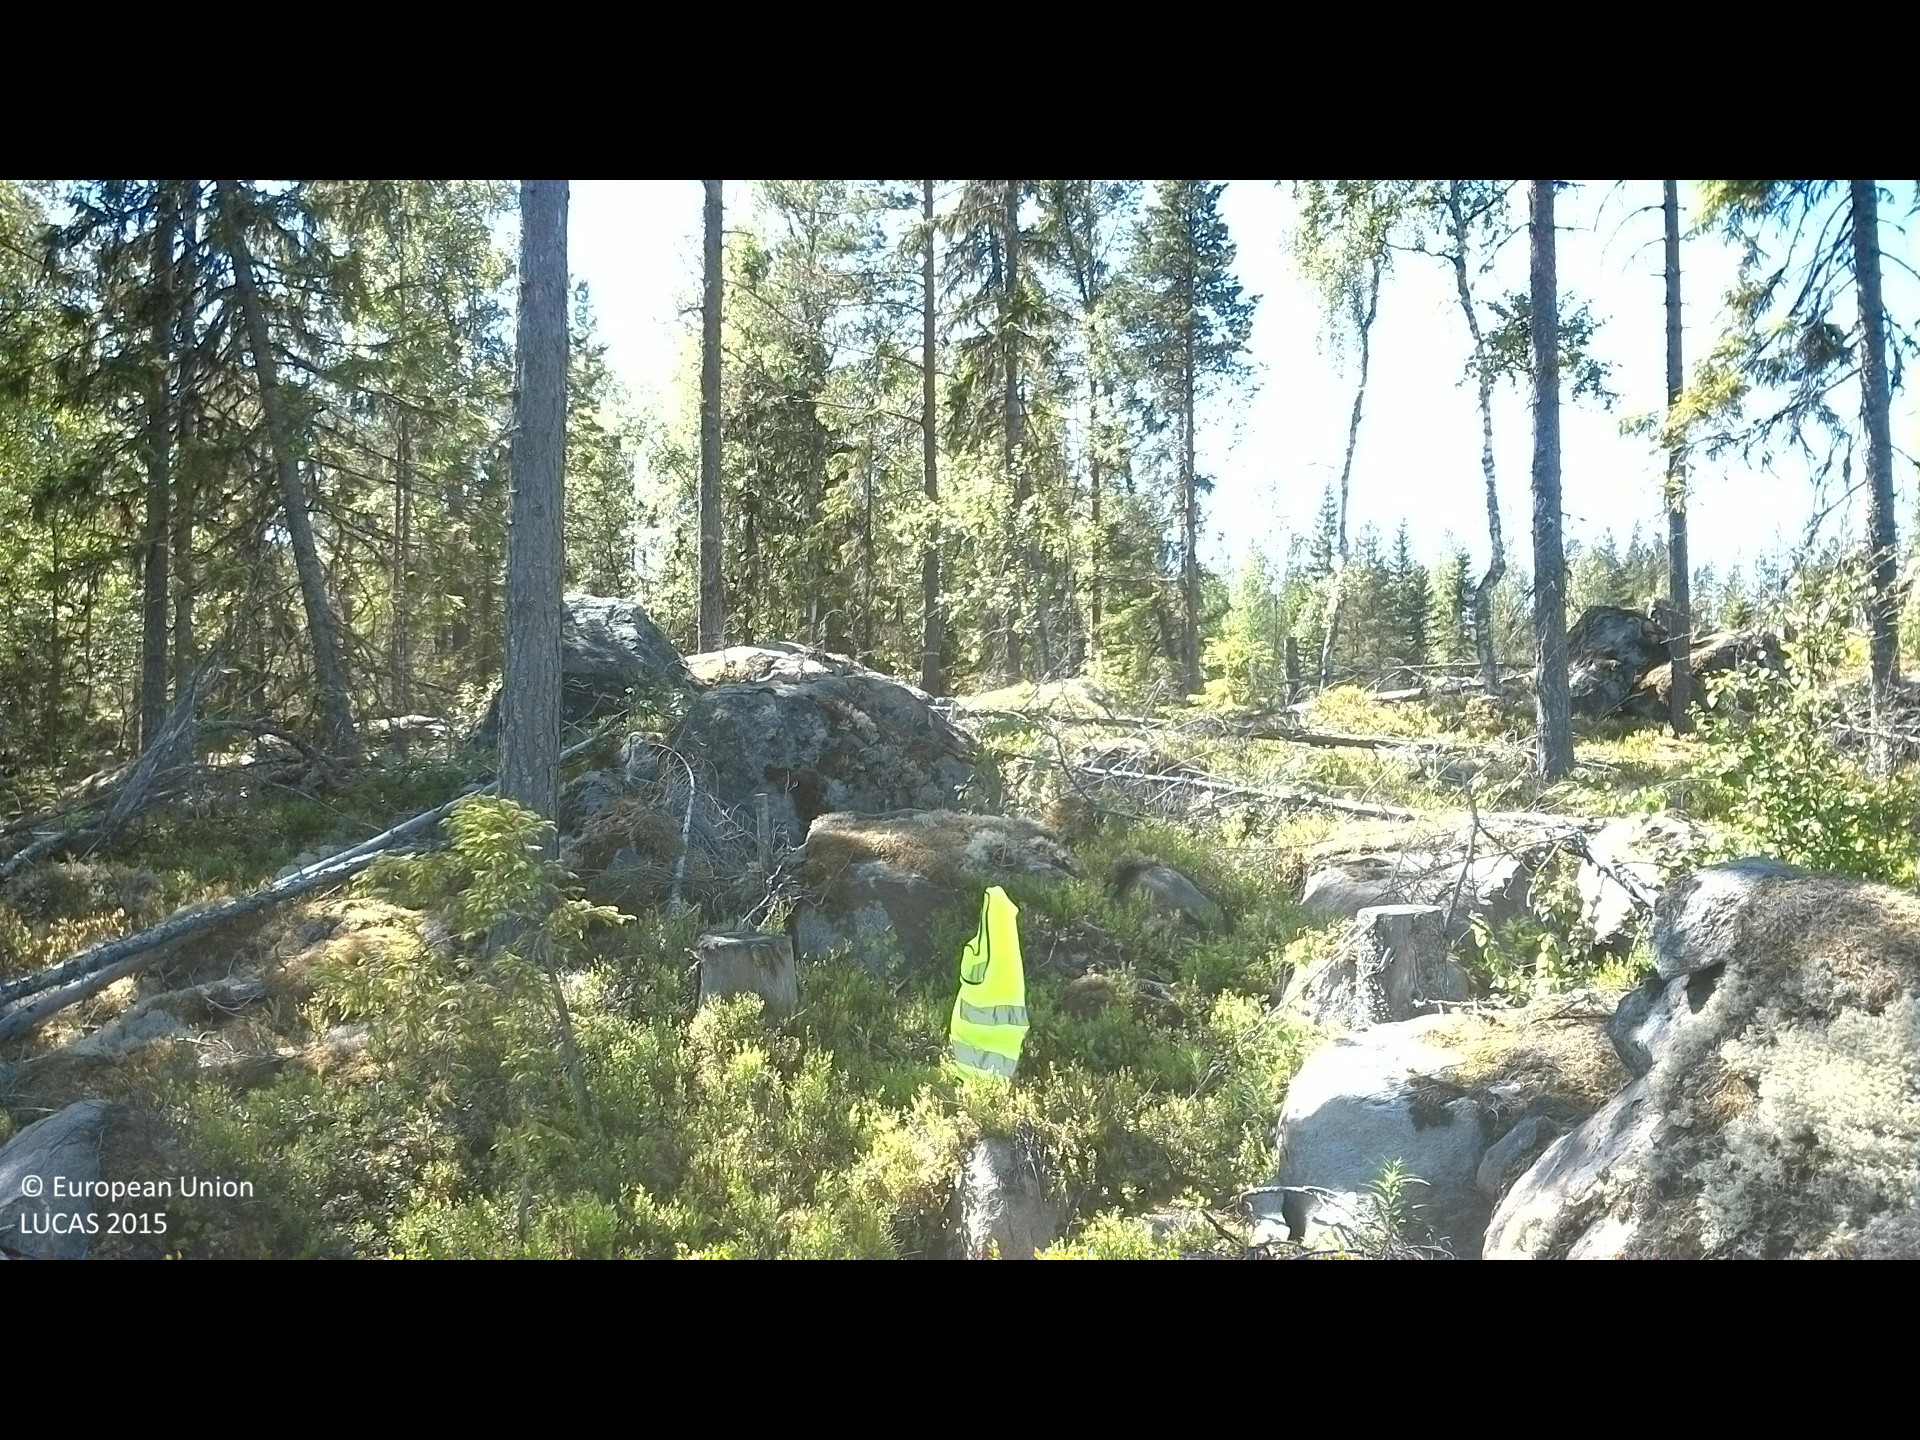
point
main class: Woodland
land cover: Spruce dominated coniferous woodland
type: boreal forest
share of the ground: 10 - 25 %
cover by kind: shrubs 55 %, coniferous forest trees 20 %, lichens and mosses 20 %, broadleaved forest trees 5 %
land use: Forestry
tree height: > 5 m
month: June
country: SE
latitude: 62.0148
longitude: 16.1900
